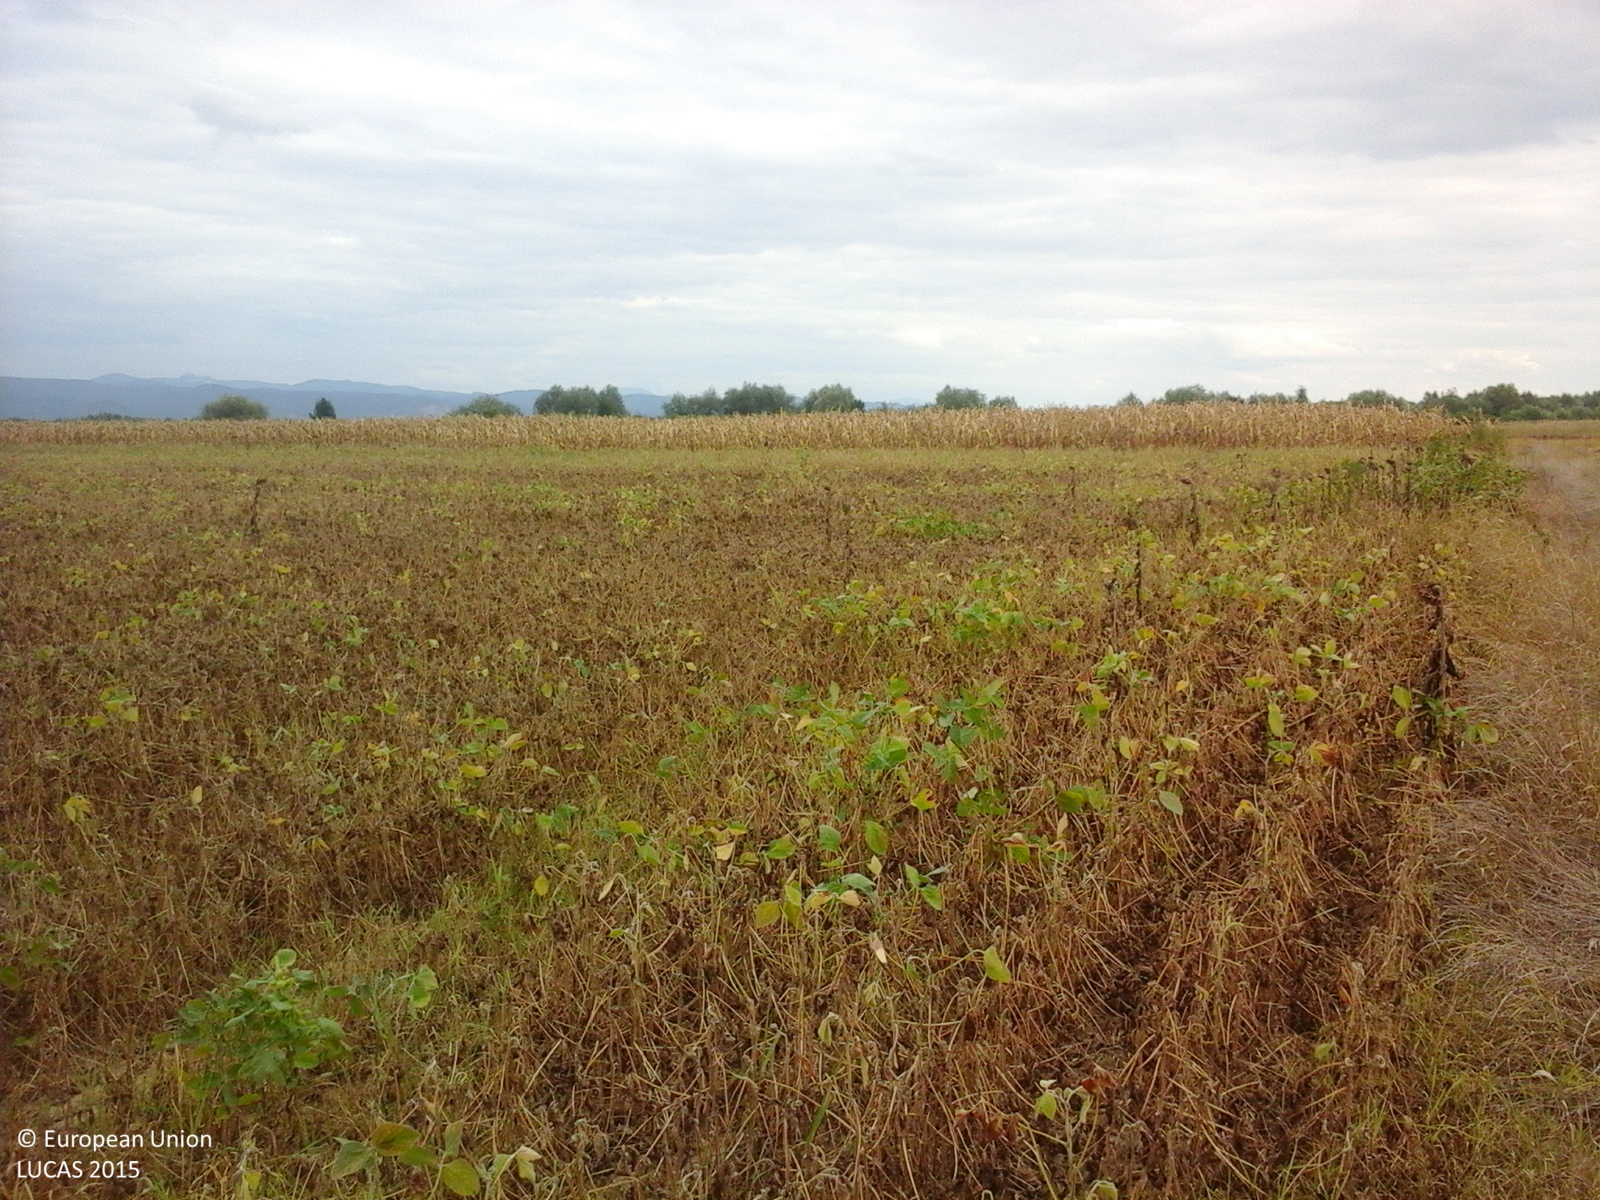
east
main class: Cropland
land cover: Soya
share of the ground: > 75 %
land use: Agriculture (excluding fallow land and kitchen gardens)
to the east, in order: Soya; Maize; Spontaneously vegetated surfaces; Lucerne; Spontaneously vegetated surfaces
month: September
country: RO
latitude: 47.7236
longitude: 23.1473
